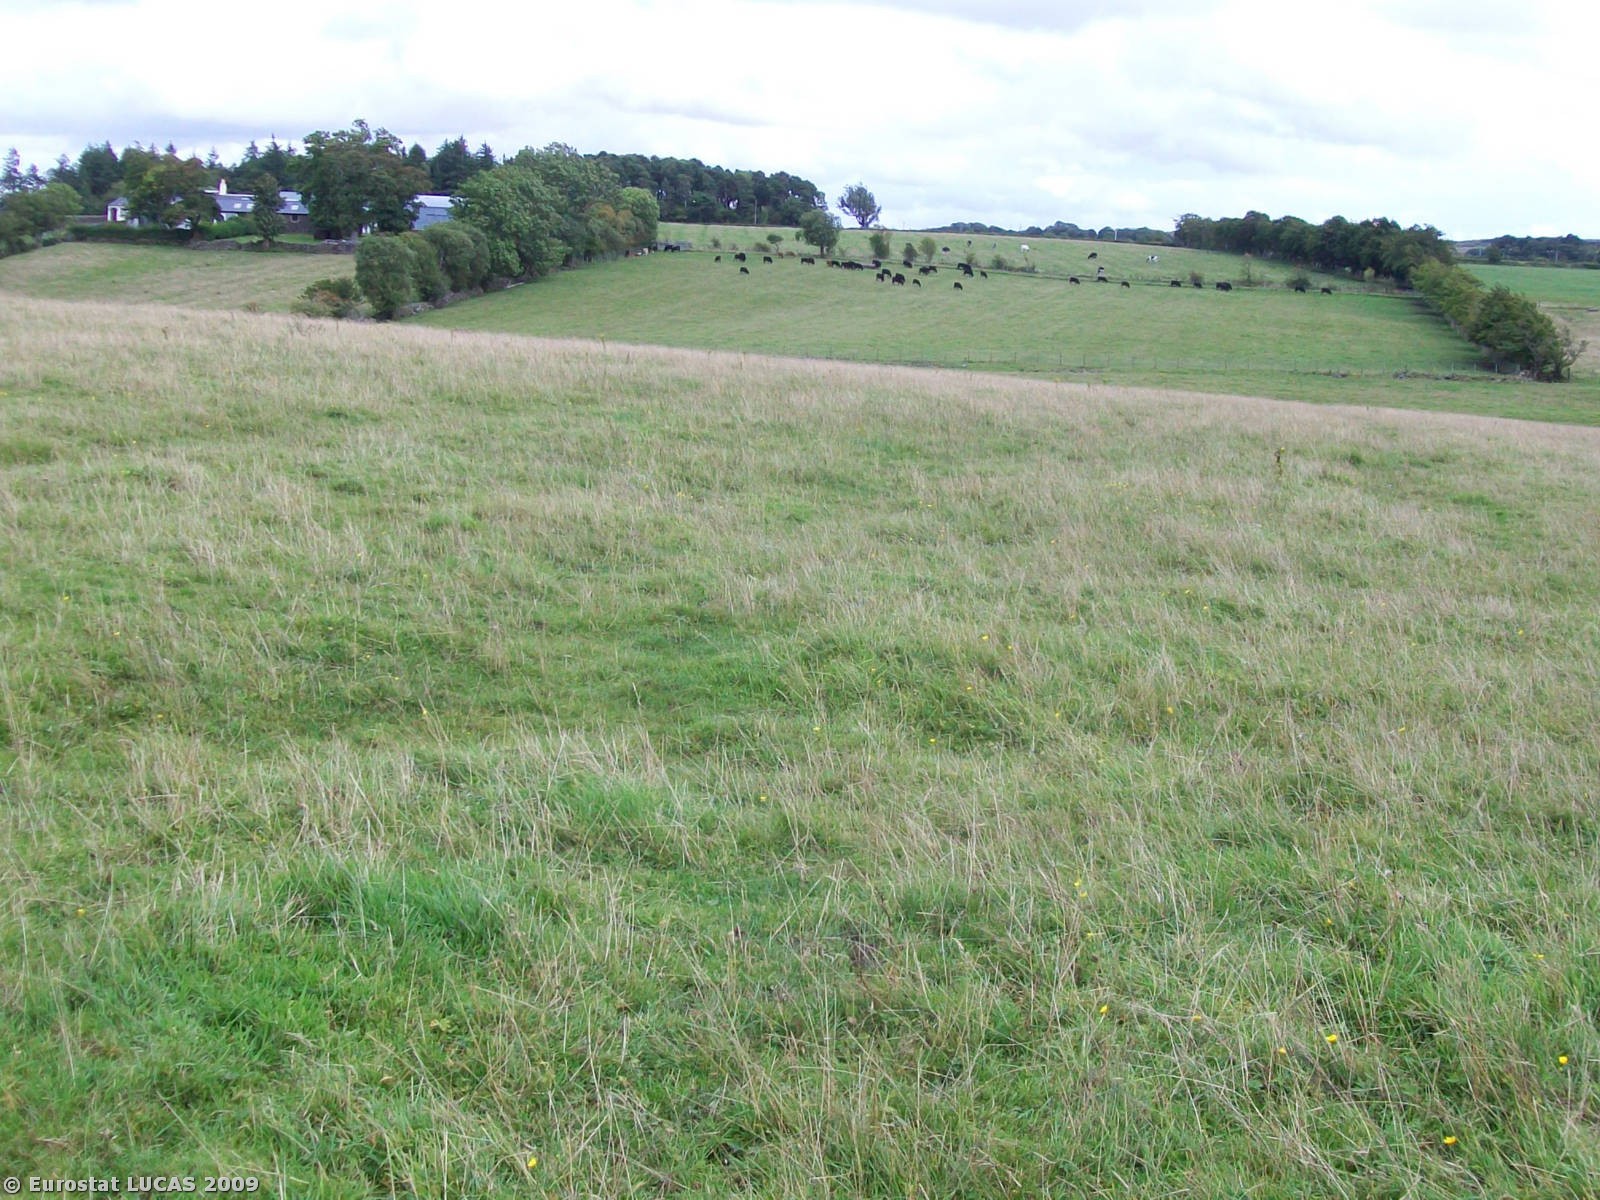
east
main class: Grassland
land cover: Grassland without tree/shrub cover
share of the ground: < 10 %
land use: Agriculture (excluding fallow land and kitchen gardens)
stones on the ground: < 10 %
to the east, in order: Grassland without tree/shrub cover; Rivers and streams; Grass margins; Fences; Grassland without tree/shrub cover
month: September
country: GB
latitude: 55.4318
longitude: -4.3355
